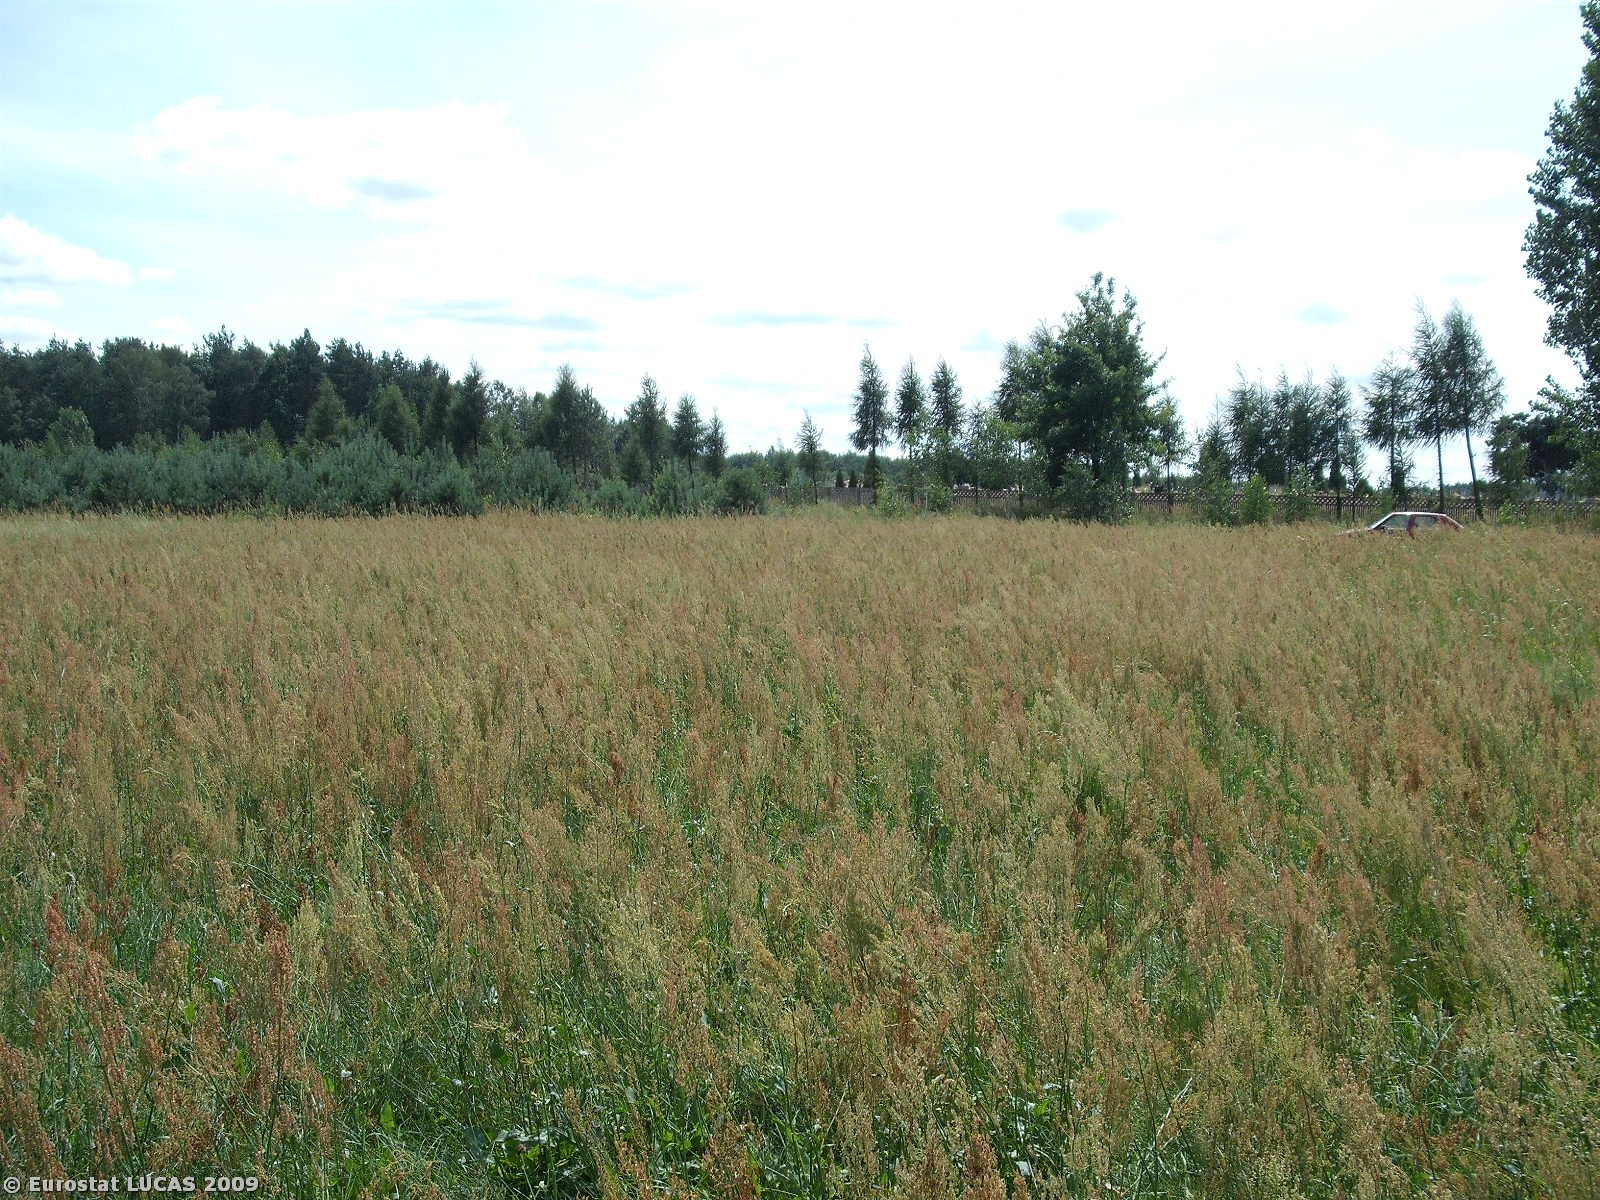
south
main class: Grassland
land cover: Grassland without tree/shrub cover
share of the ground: > 75 %
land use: Agriculture (excluding fallow land and kitchen gardens)
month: July
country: PL
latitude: 51.3122
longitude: 21.4560
